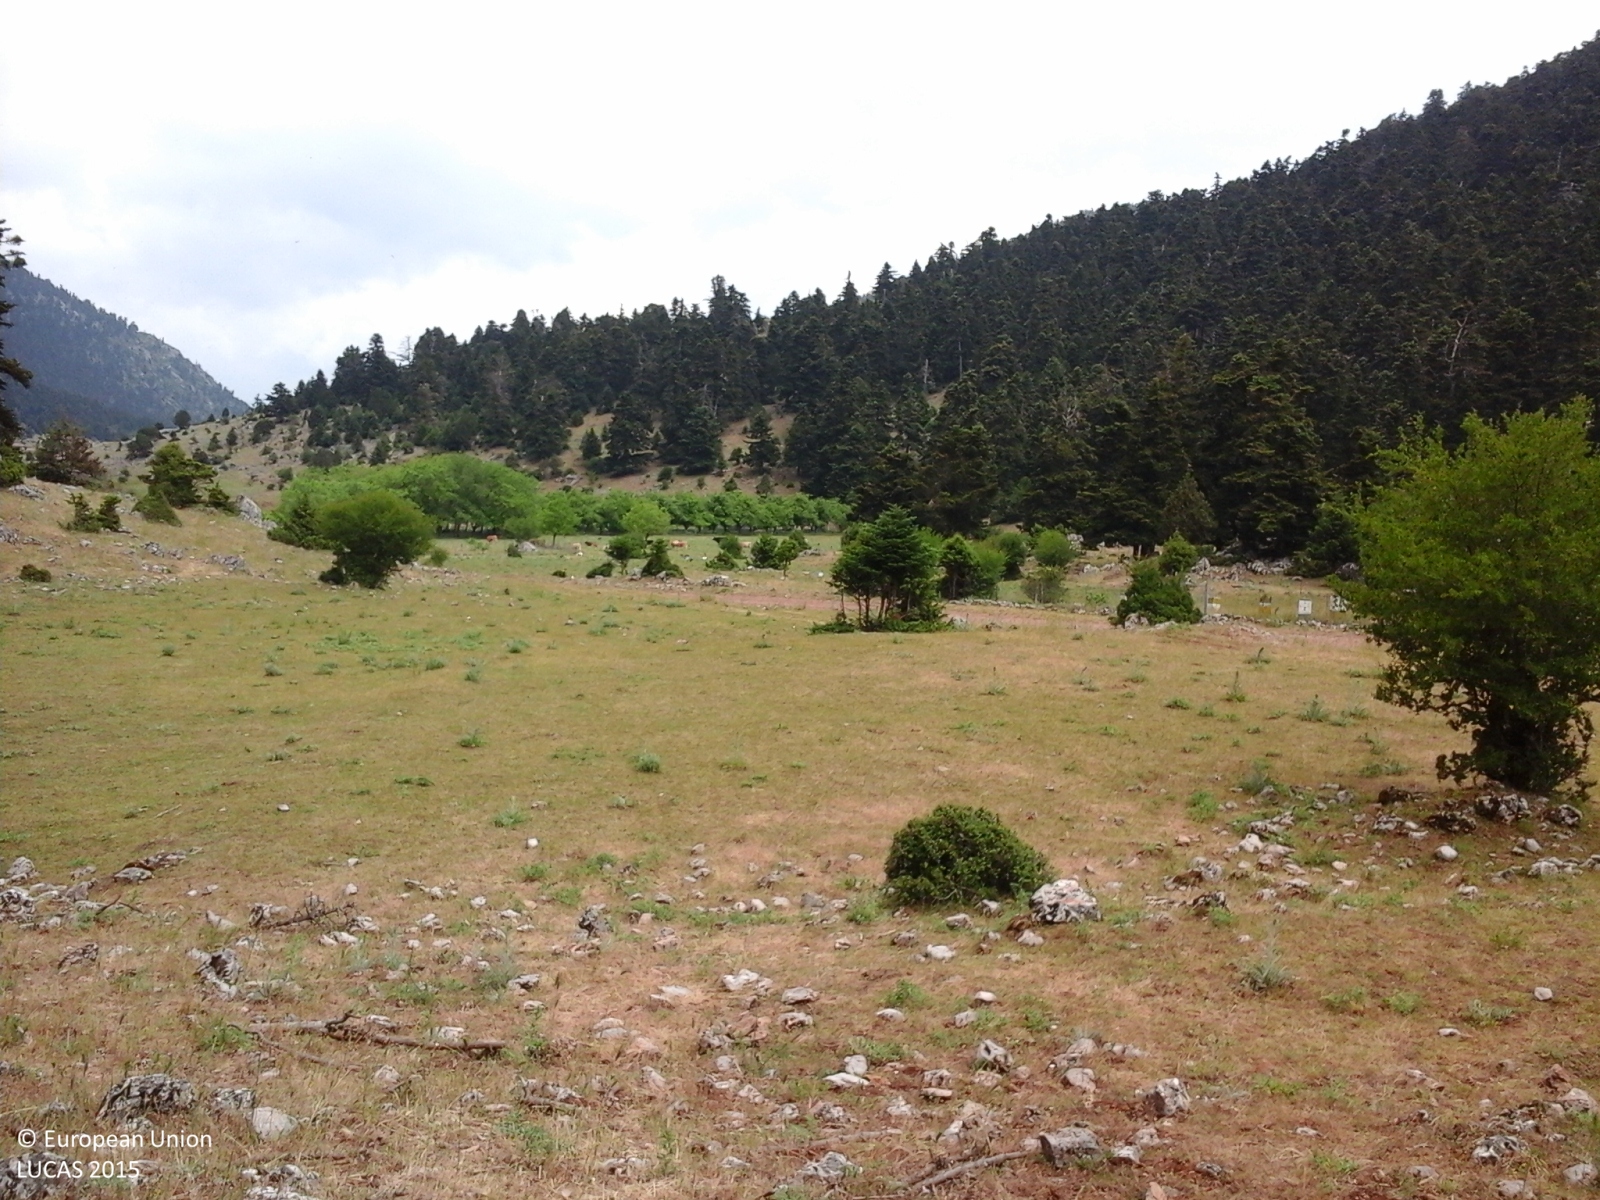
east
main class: Grassland
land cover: Grassland with sparse tree/shrub cover
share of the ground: > 75 %
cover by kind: herbaceous plants 85 %, coniferous forest trees 5 %, shrubs 5 %, unconsolidated bare surface 5 %
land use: Agriculture (excluding fallow land and kitchen gardens)
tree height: < 5 m
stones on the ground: < 10 %
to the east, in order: Grassland with sparse tree/shrub cover; Dry stone walls; Grassland with sparse tree/shrub cover; Dry stone walls; Grassland with sparse tree/shrub cover; Tracks; Grassland with sparse tree/shrub cover; Dry stone walls; Grassland with sparse tree/shrub cover
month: June
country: GR
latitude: 38.4844
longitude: 22.2980
